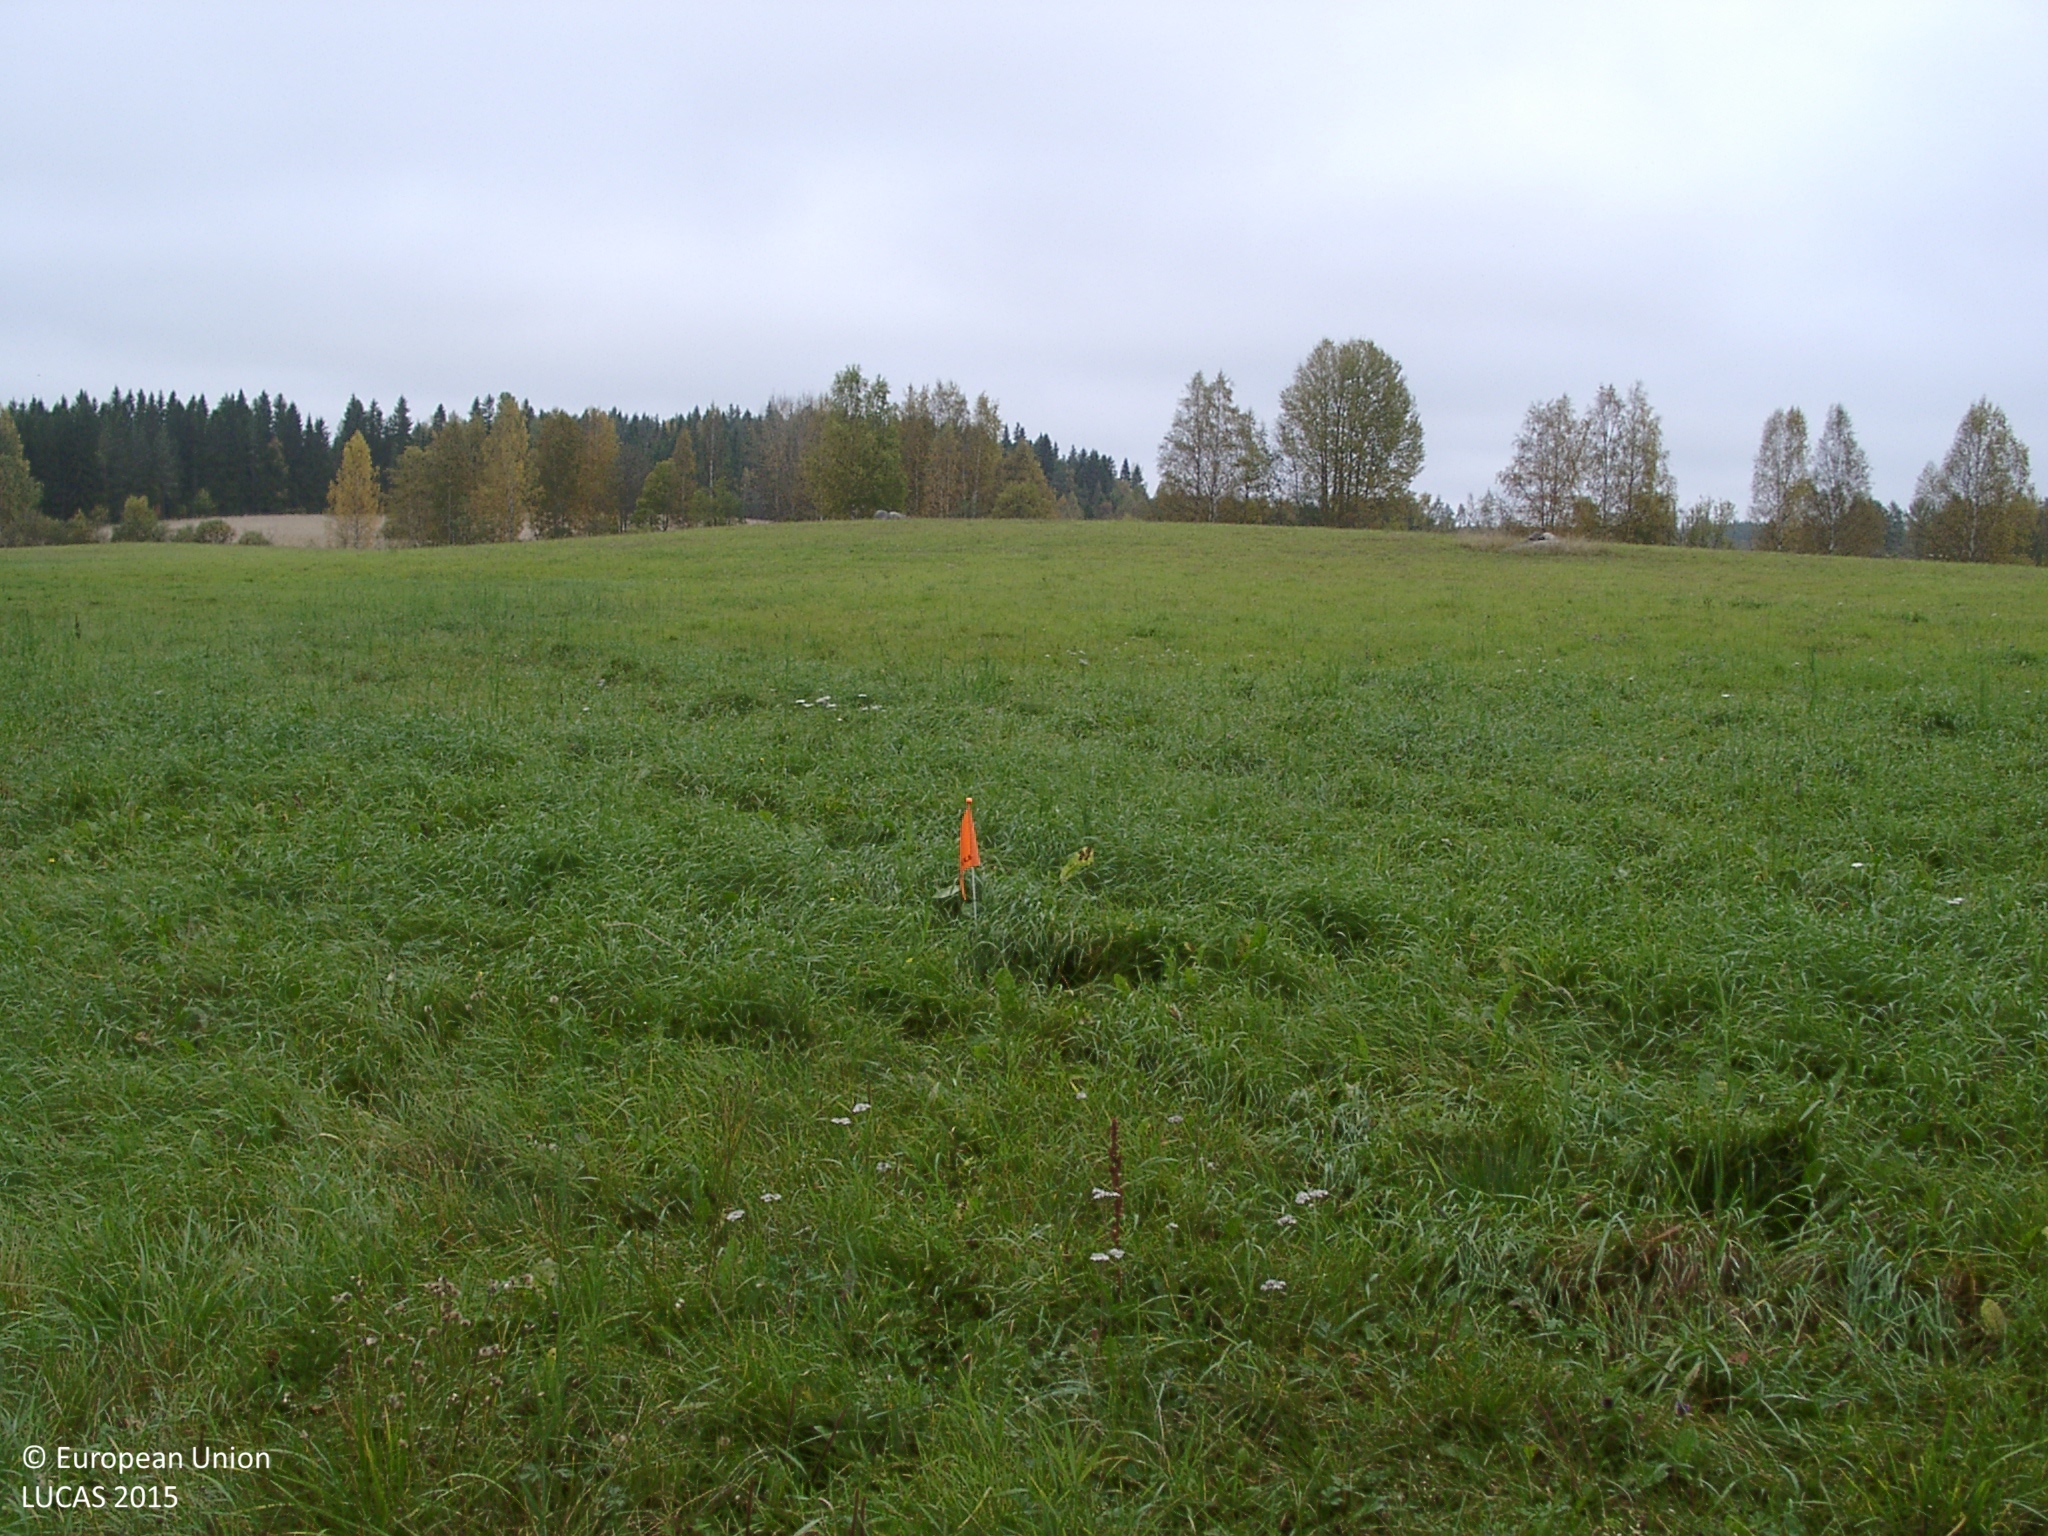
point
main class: Grassland
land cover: Grassland without tree/shrub cover
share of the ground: > 75 %
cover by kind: herbaceous plants 100 %
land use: Agriculture (excluding fallow land and kitchen gardens)
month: September
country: FI
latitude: 62.6565
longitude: 25.2678
